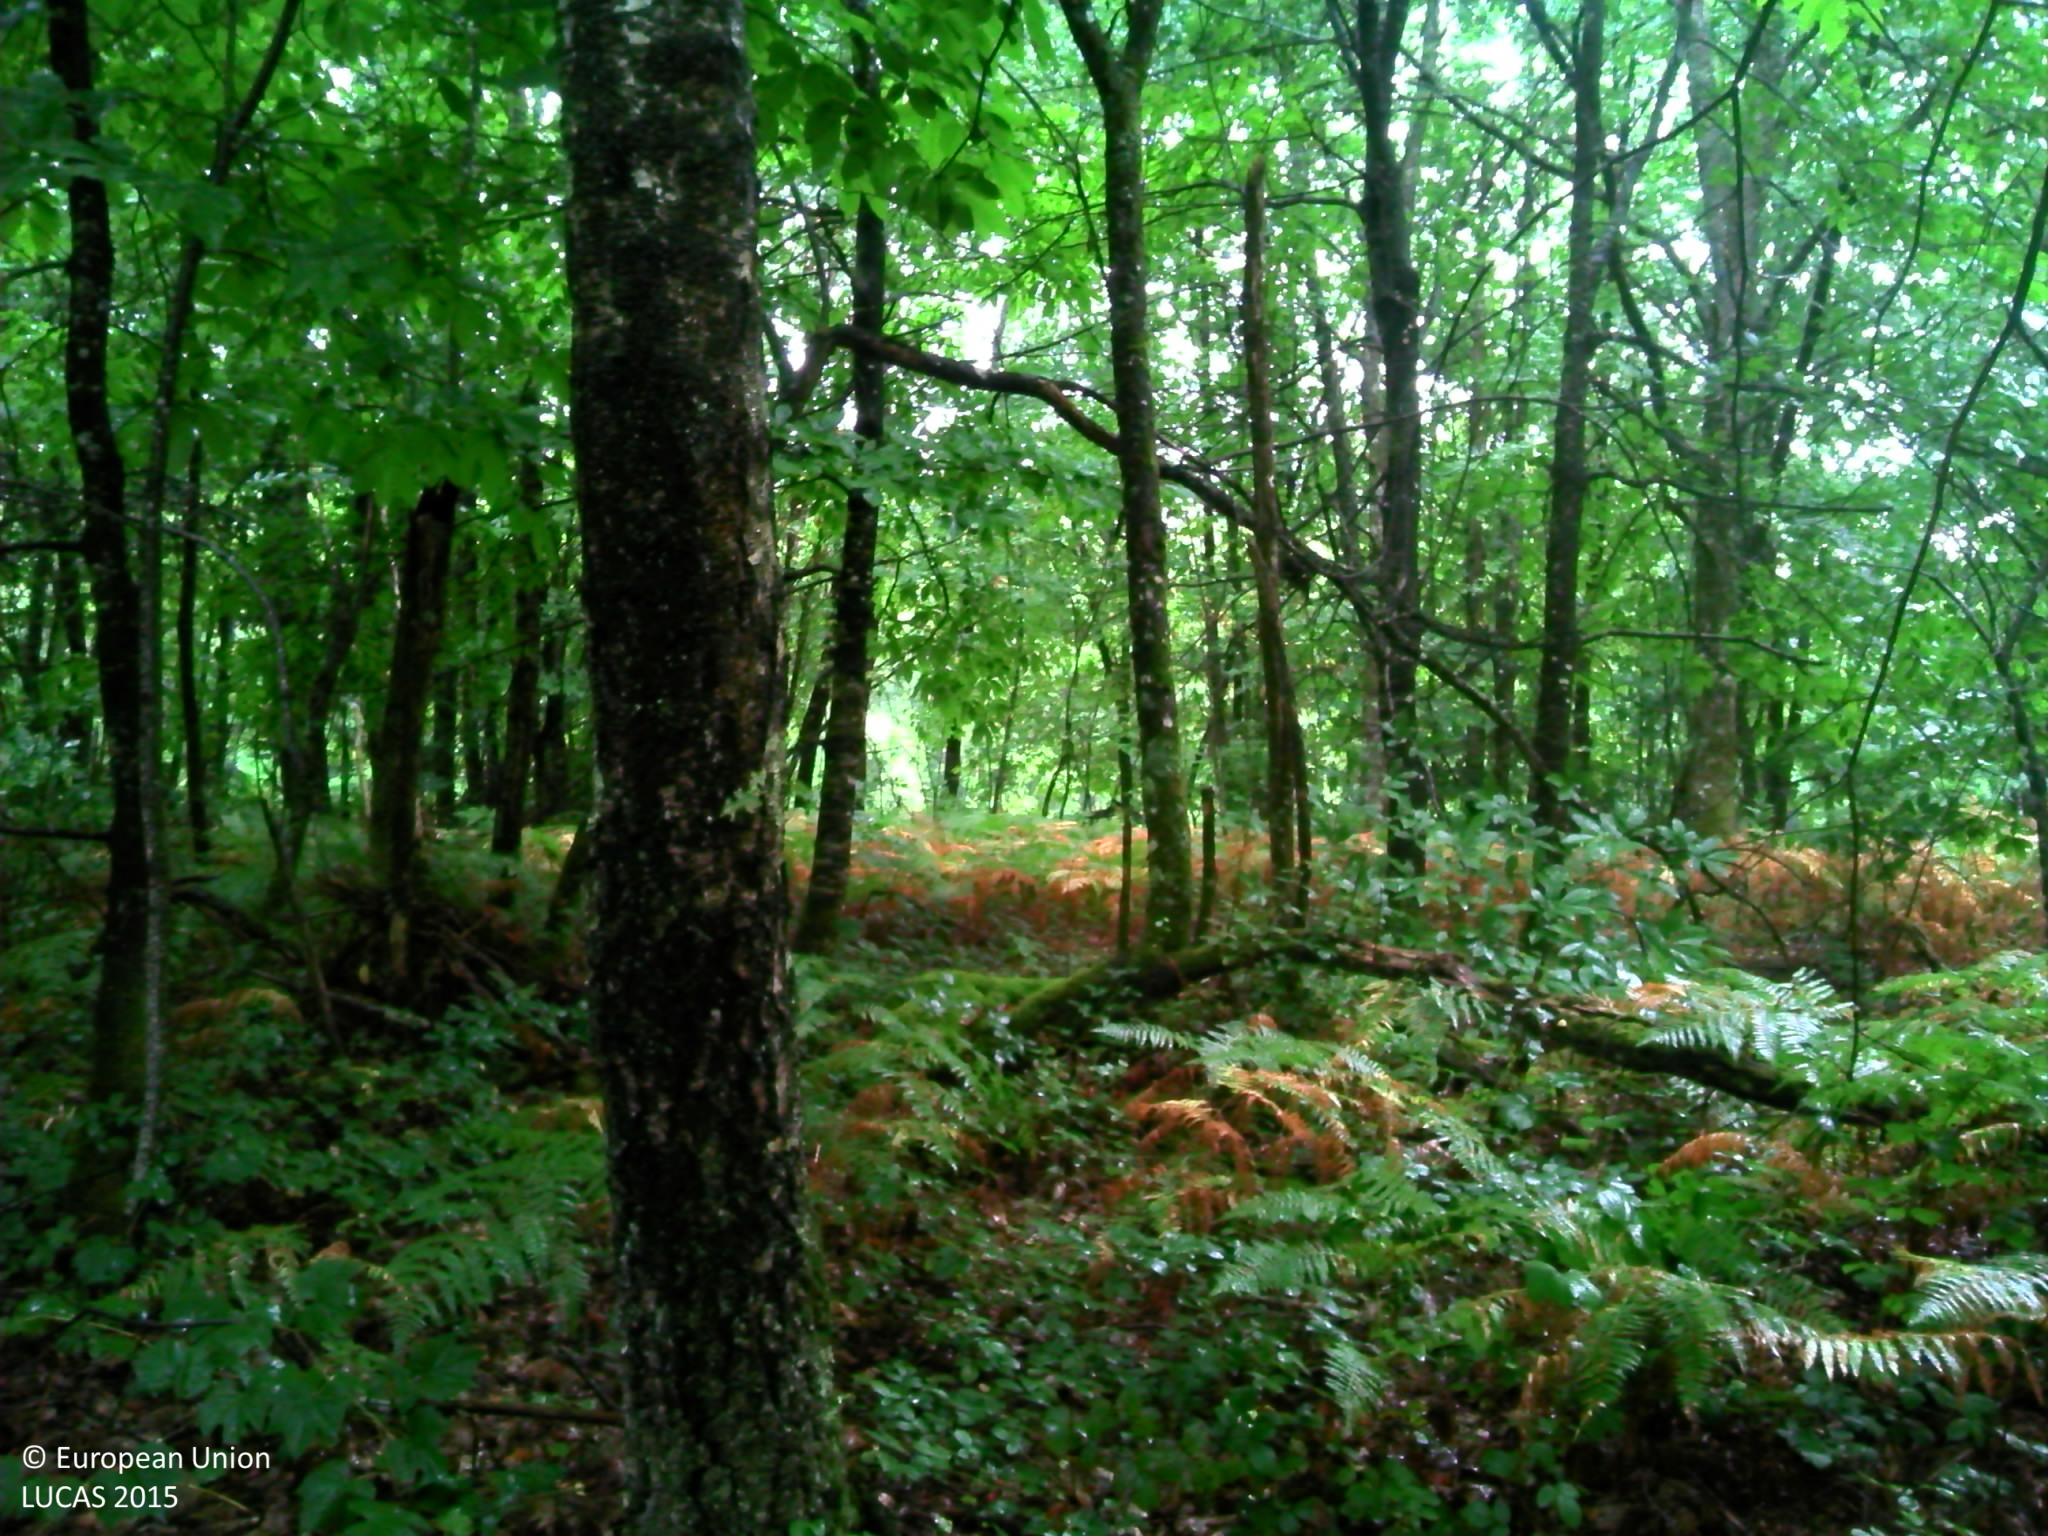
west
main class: Woodland
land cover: Broadleaved woodland
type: thermophilous deciduous forest
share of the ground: > 75 %
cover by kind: broadleaved forest trees 75 %, herbaceous plants 10 %, shrubs 5 %, lichens and mosses 5 %, consolidated bare surface 5 %
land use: Forestry
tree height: > 5 m
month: August
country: FR
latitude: 45.4684
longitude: 0.6383
